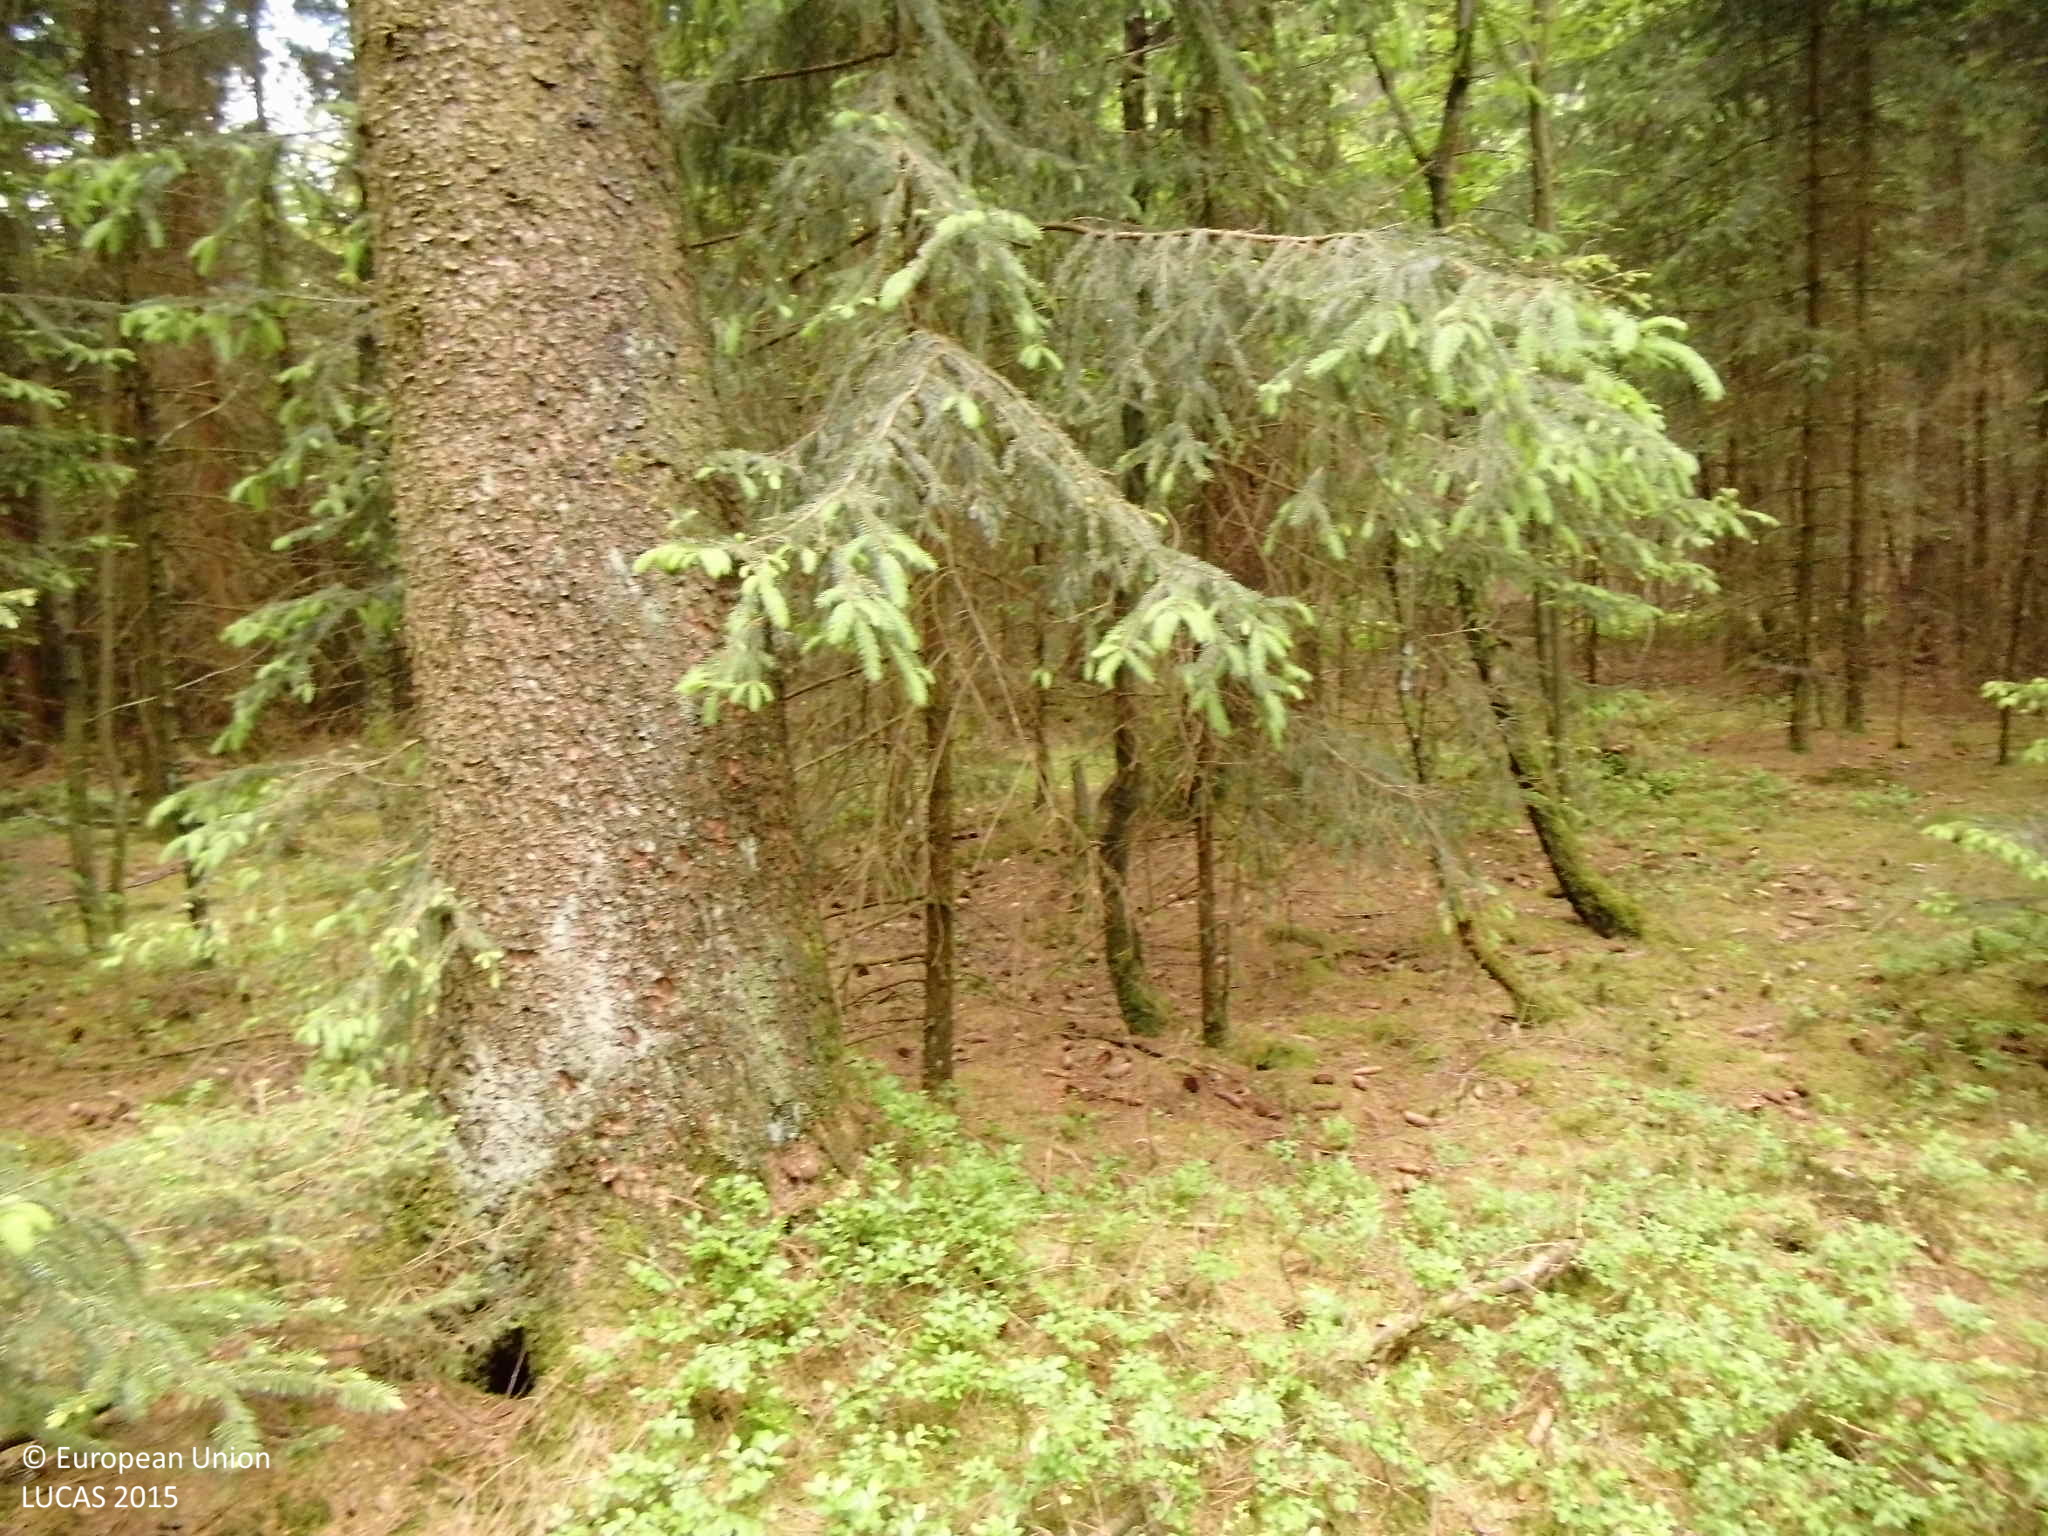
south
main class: Woodland
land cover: Spruce dominated coniferous woodland
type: hemiboreal forest and nemoral coniferous forest and mixed broadleaved-coniferous forest
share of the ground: > 75 %
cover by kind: coniferous forest trees 75 %, lichens and mosses 15 %, broadleaved forest trees 5 %, herbaceous plants 5 %
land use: Forestry
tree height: > 5 m
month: June
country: DE
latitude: 51.0478
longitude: 7.9891
